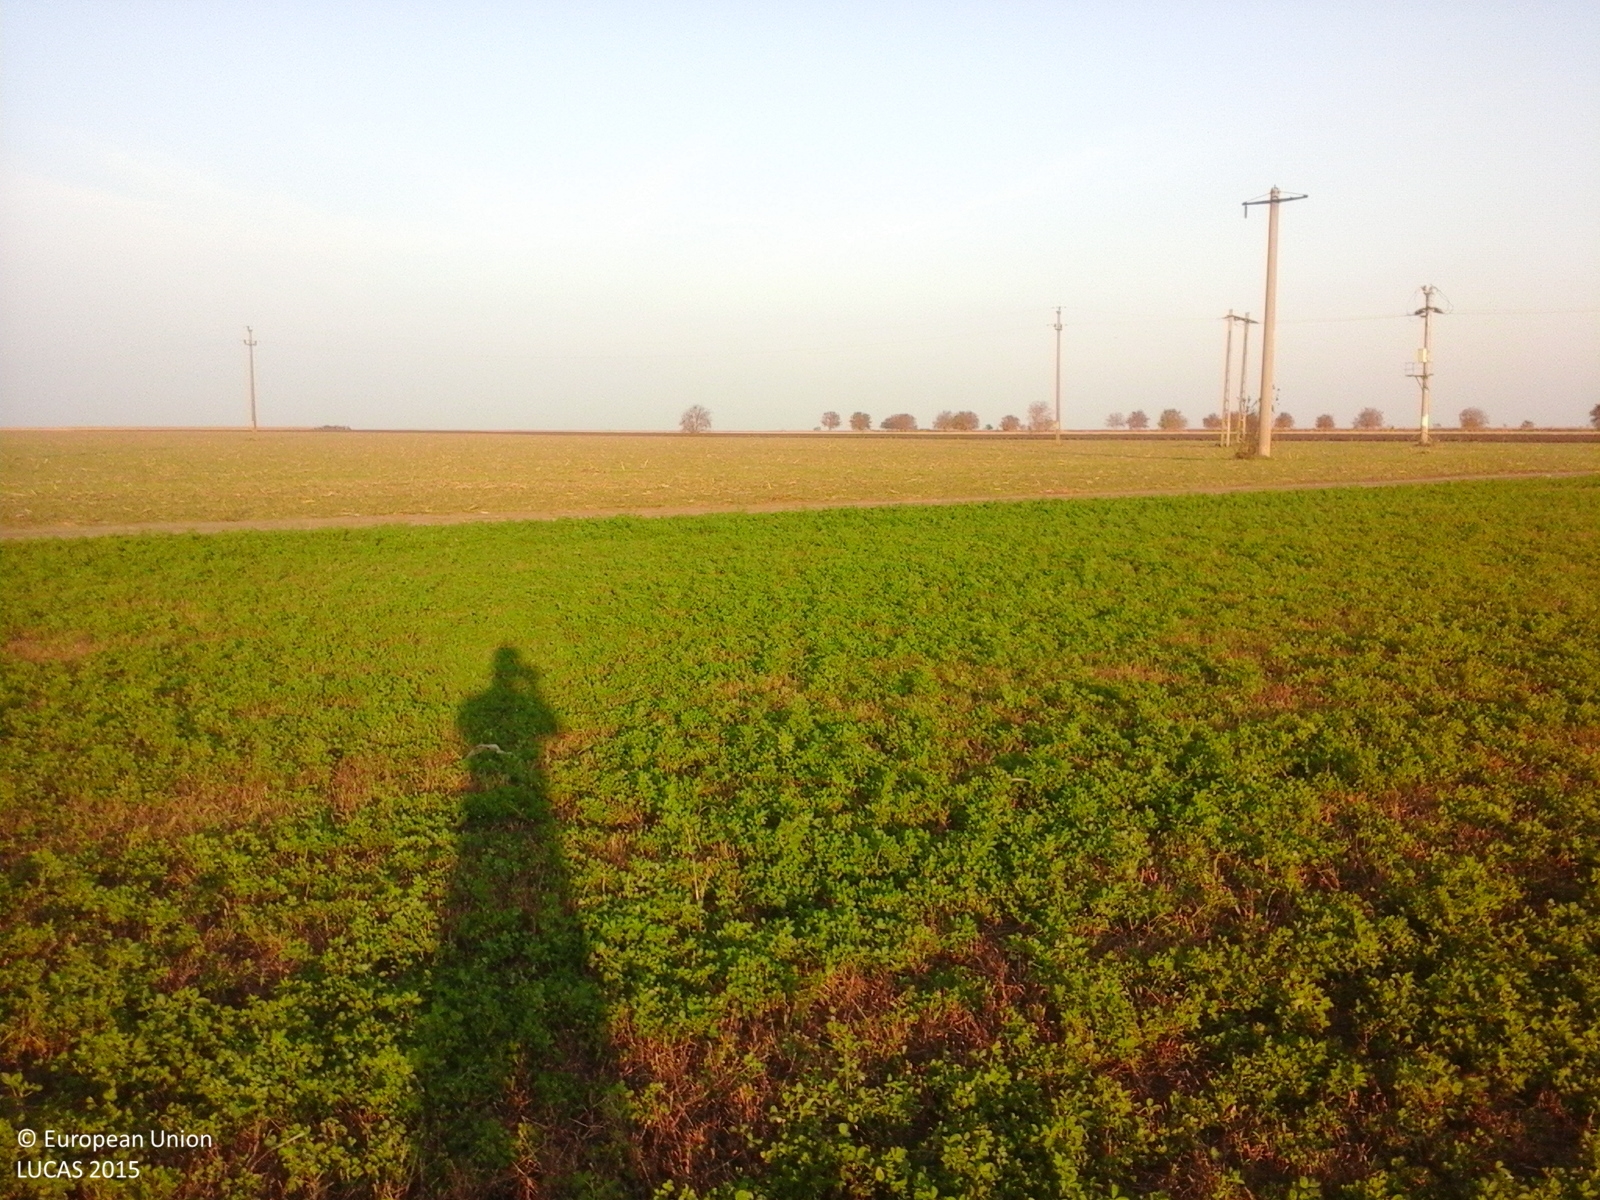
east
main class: Cropland
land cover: Lucerne
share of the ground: > 75 %
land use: Agriculture (excluding fallow land and kitchen gardens)
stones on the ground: < 10 %
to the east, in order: Lucerne; Grass margins; Tracks; Grass margins; Common wheat; Electric lines; Common wheat; Other bare soil
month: October
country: RO
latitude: 45.1318
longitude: 26.9563
